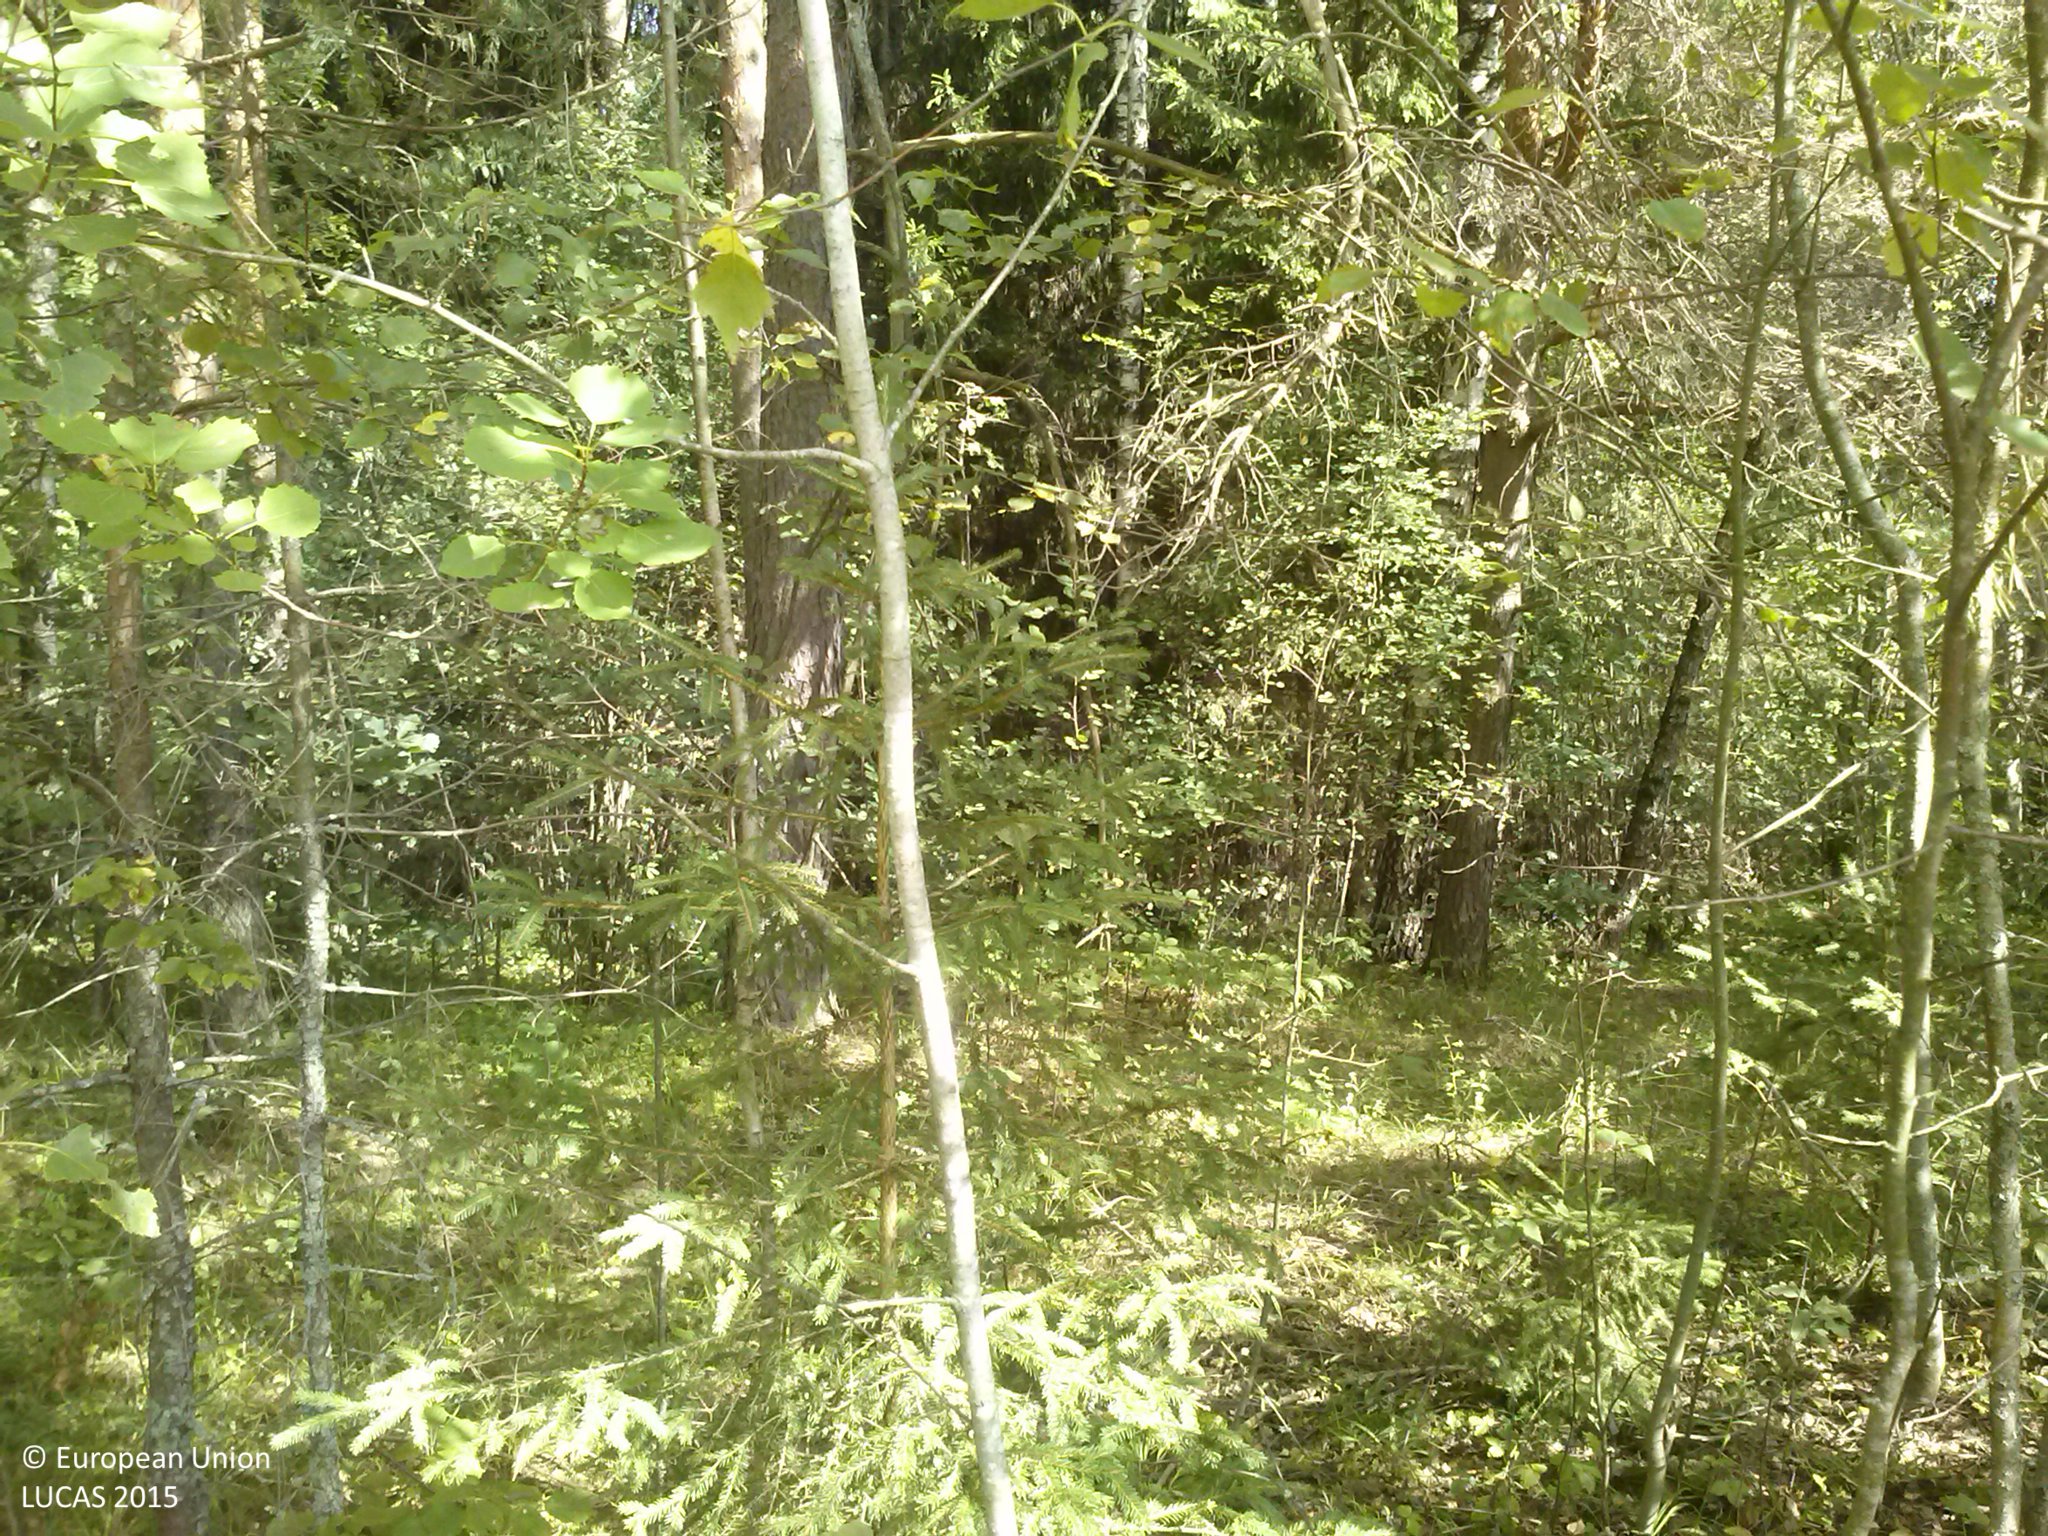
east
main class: Woodland
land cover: Pine dominated mixed woodland
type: hemiboreal forest and nemoral coniferous forest and mixed broadleaved-coniferous forest
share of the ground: > 75 %
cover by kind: coniferous forest trees 50 %, broadleaved forest trees 25 %, herbaceous plants 15 %, shrubs 5 %, lichens and mosses 5 %
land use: Forestry
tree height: > 5 m
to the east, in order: Pine dominated mixed woodland; Spruce dominated coniferous woodland; Broadleaved woodland; Spruce dominated coniferous woodland; Spruce dominated mixed woodland; Broadleaved woodland; Ditches and canals; Broadleaved woodland
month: August
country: LV
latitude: 56.2346
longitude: 26.8906
